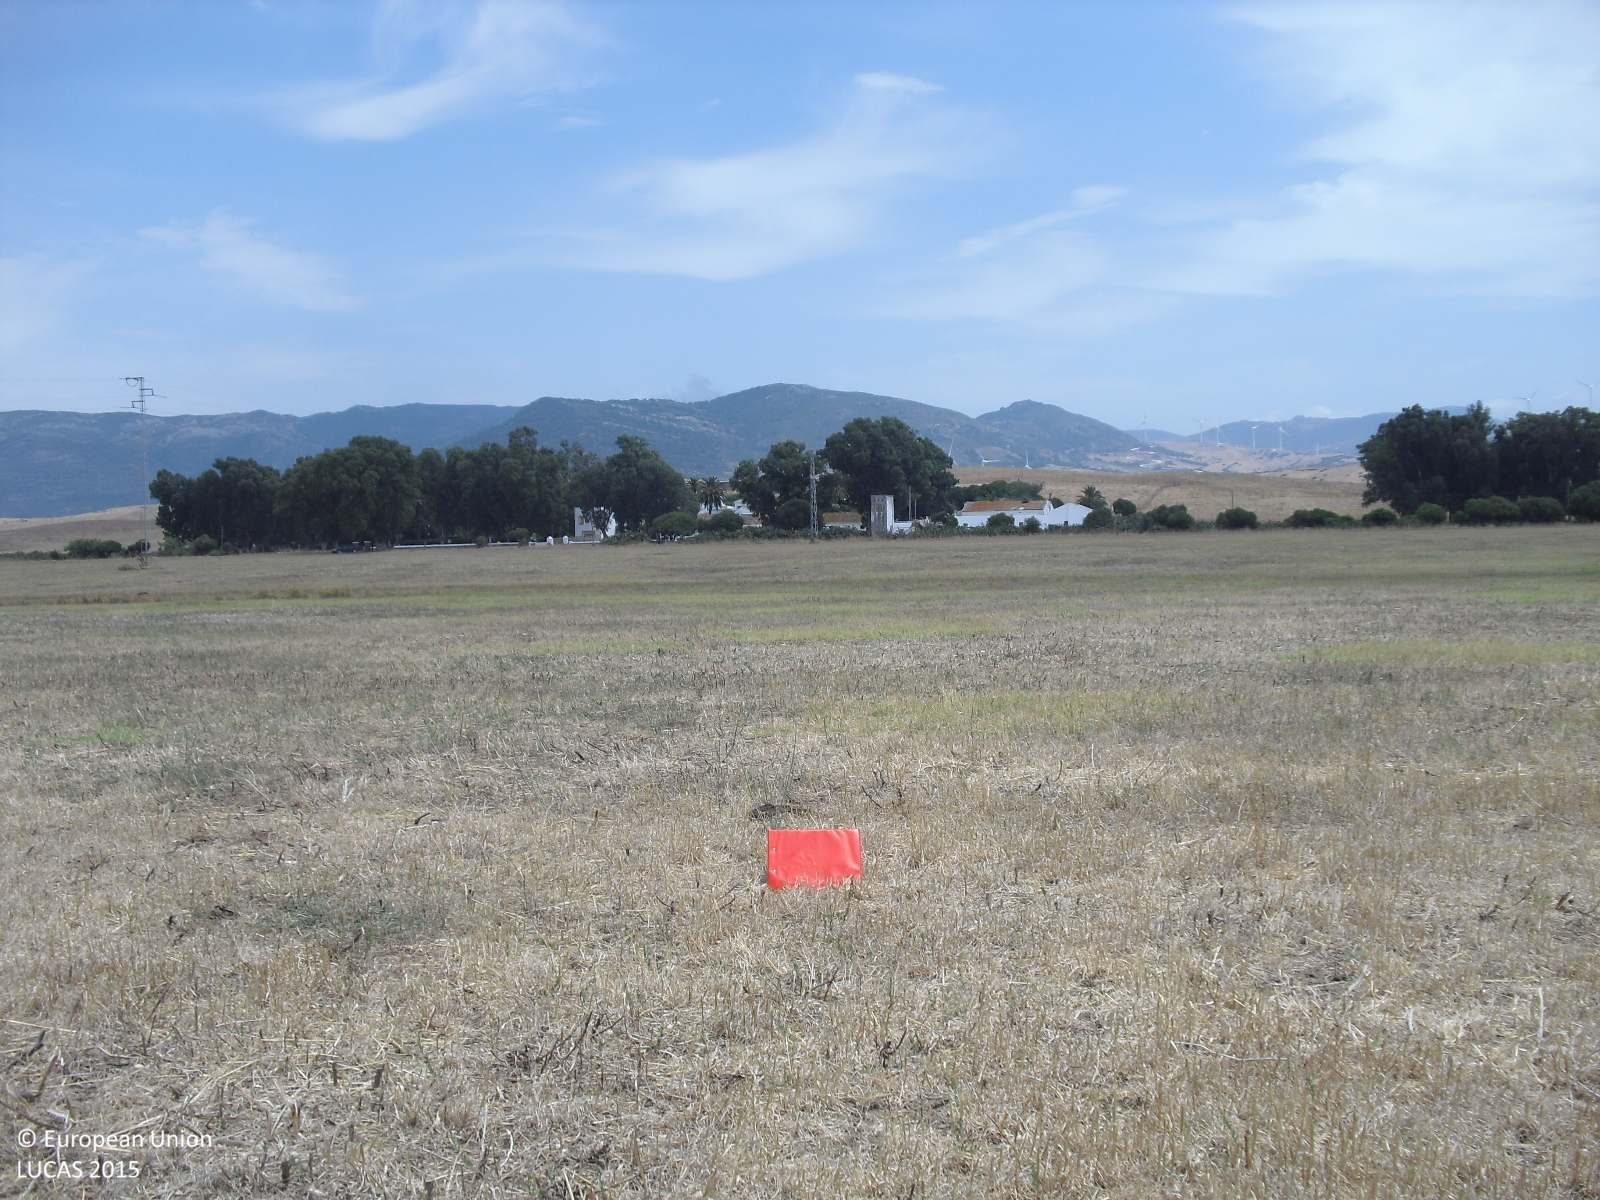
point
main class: Grassland
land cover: Spontaneously vegetated surfaces
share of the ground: 25 - 50 %
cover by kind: unconsolidated bare surface 65 %, herbaceous plants 35 %
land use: Agriculture (excluding fallow land and kitchen gardens)
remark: Harvested field
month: July
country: ES
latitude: 36.0585
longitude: -5.6344
